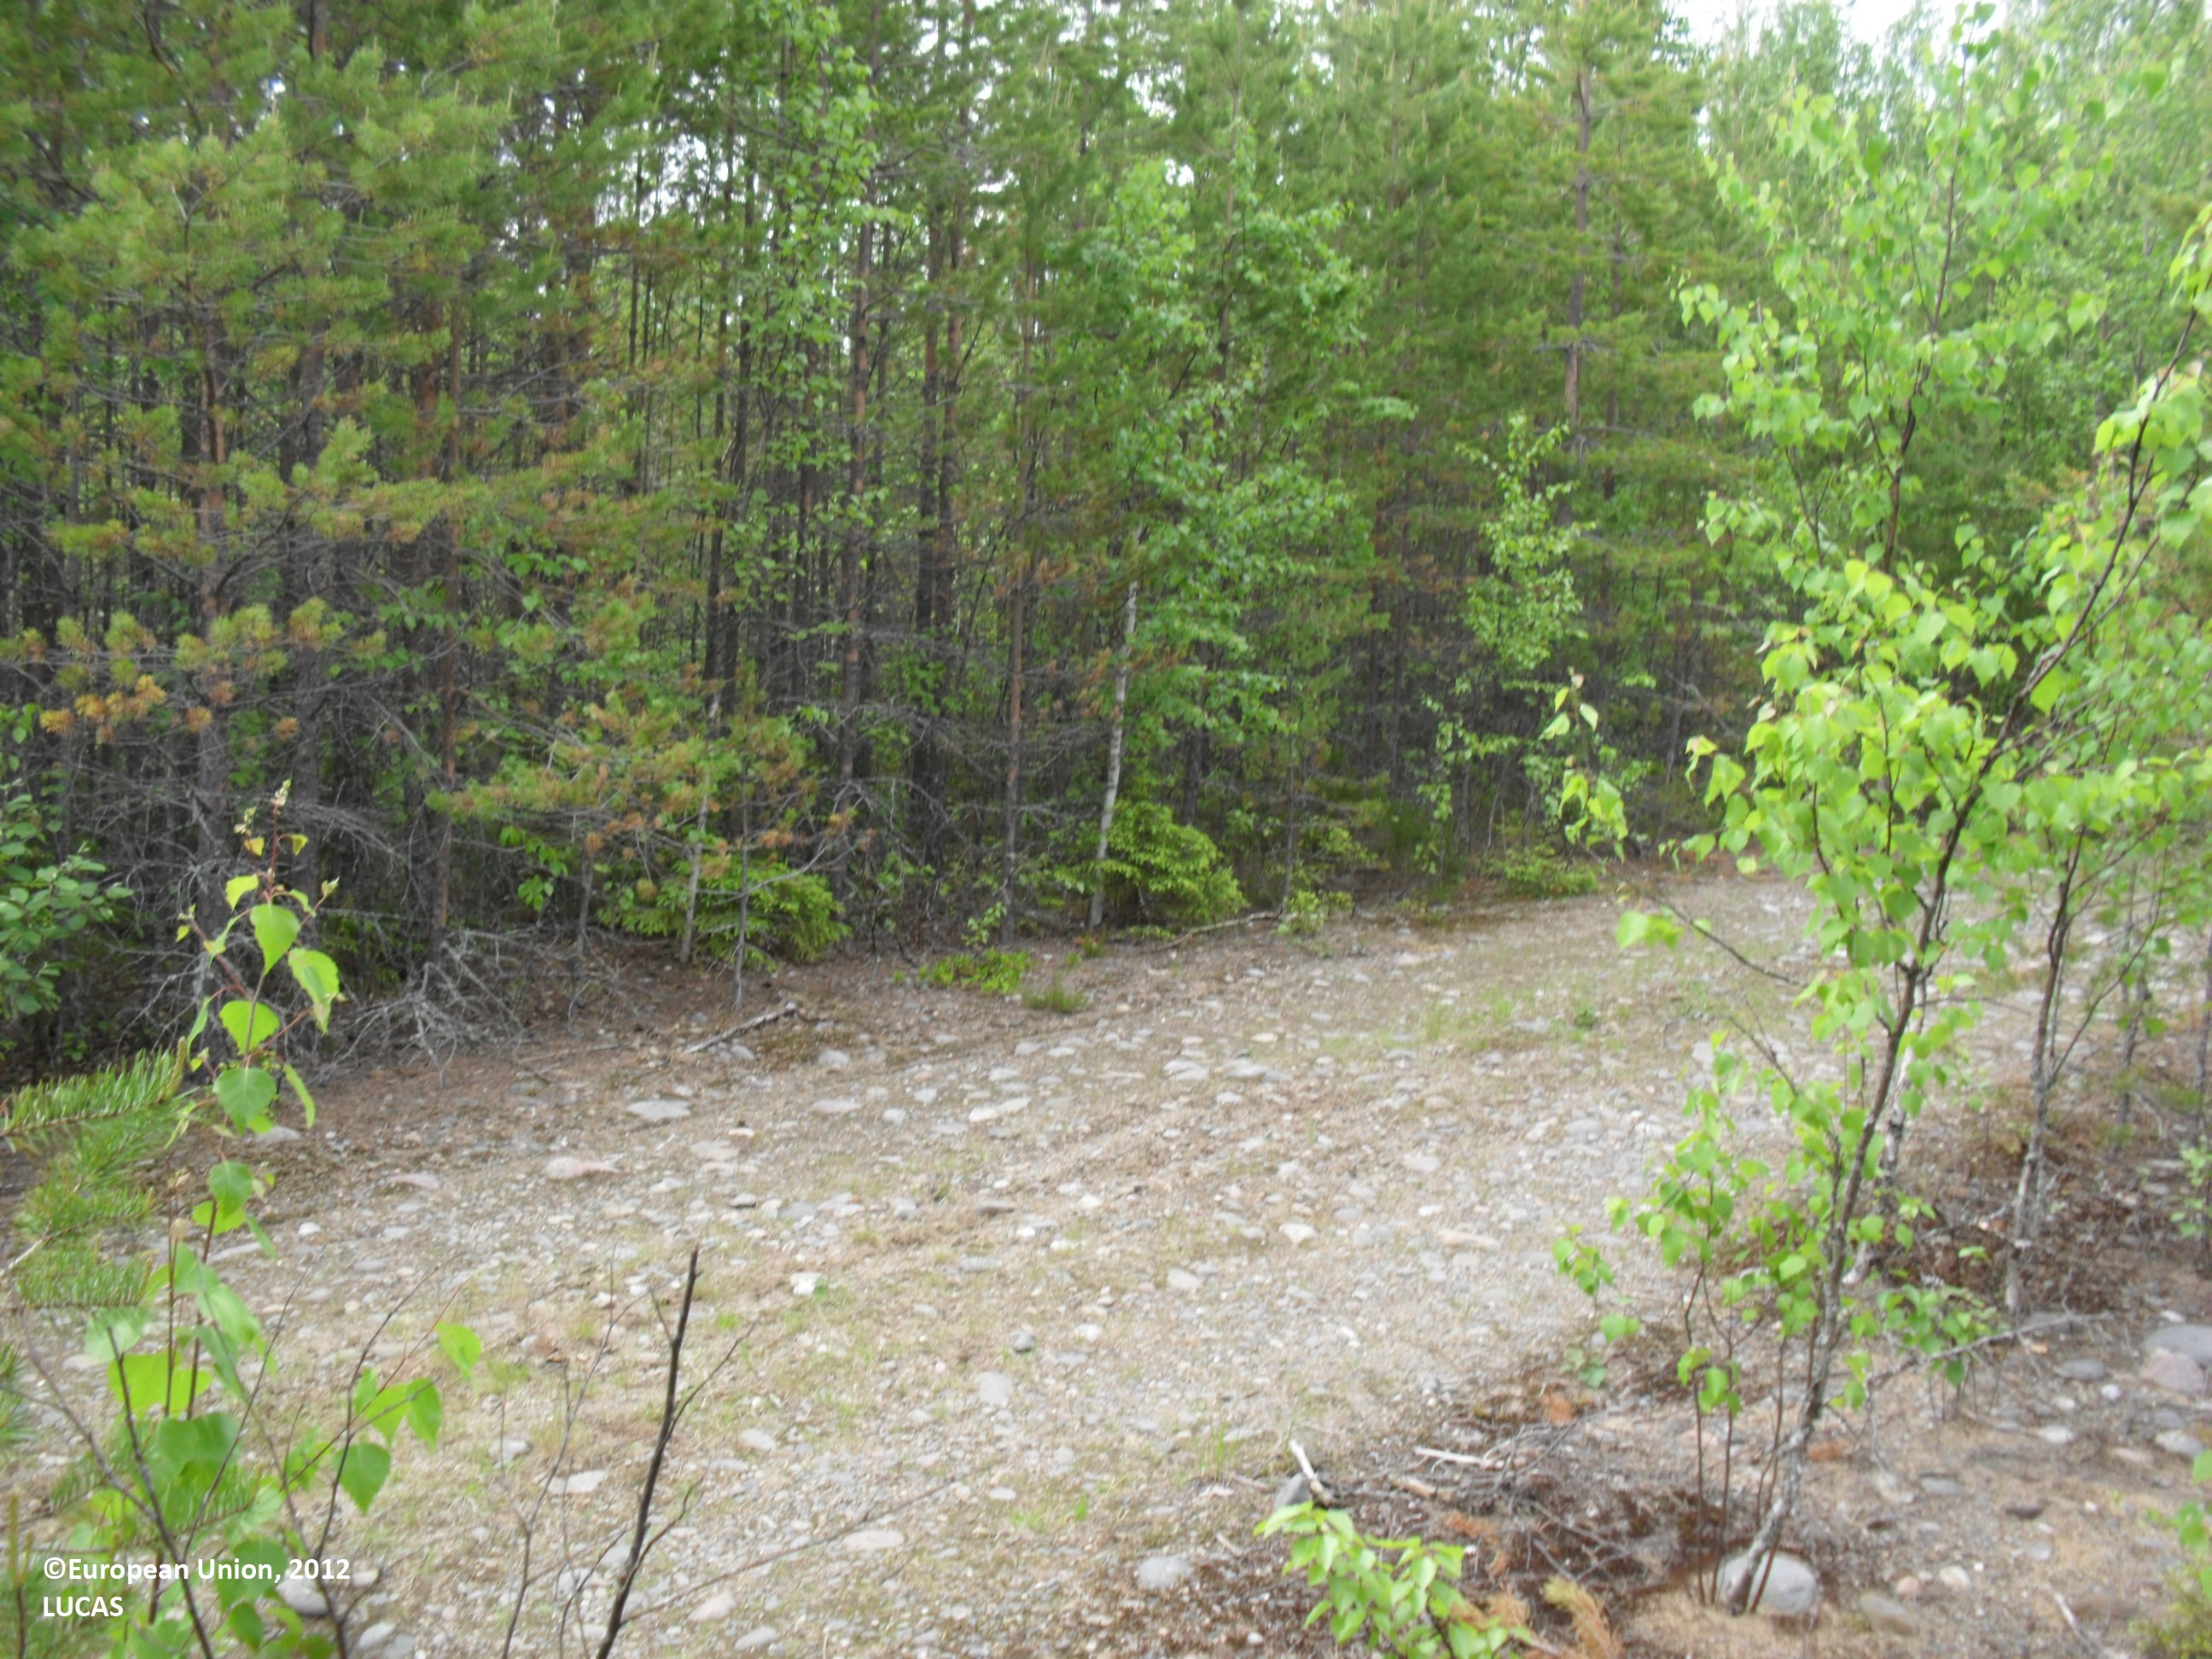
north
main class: Woodland
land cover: Pine dominated coniferous woodland
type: boreal forest
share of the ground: 50 - 75 %
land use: Forestry
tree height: < 5 m
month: June
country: FI
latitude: 63.0440
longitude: 23.7336
